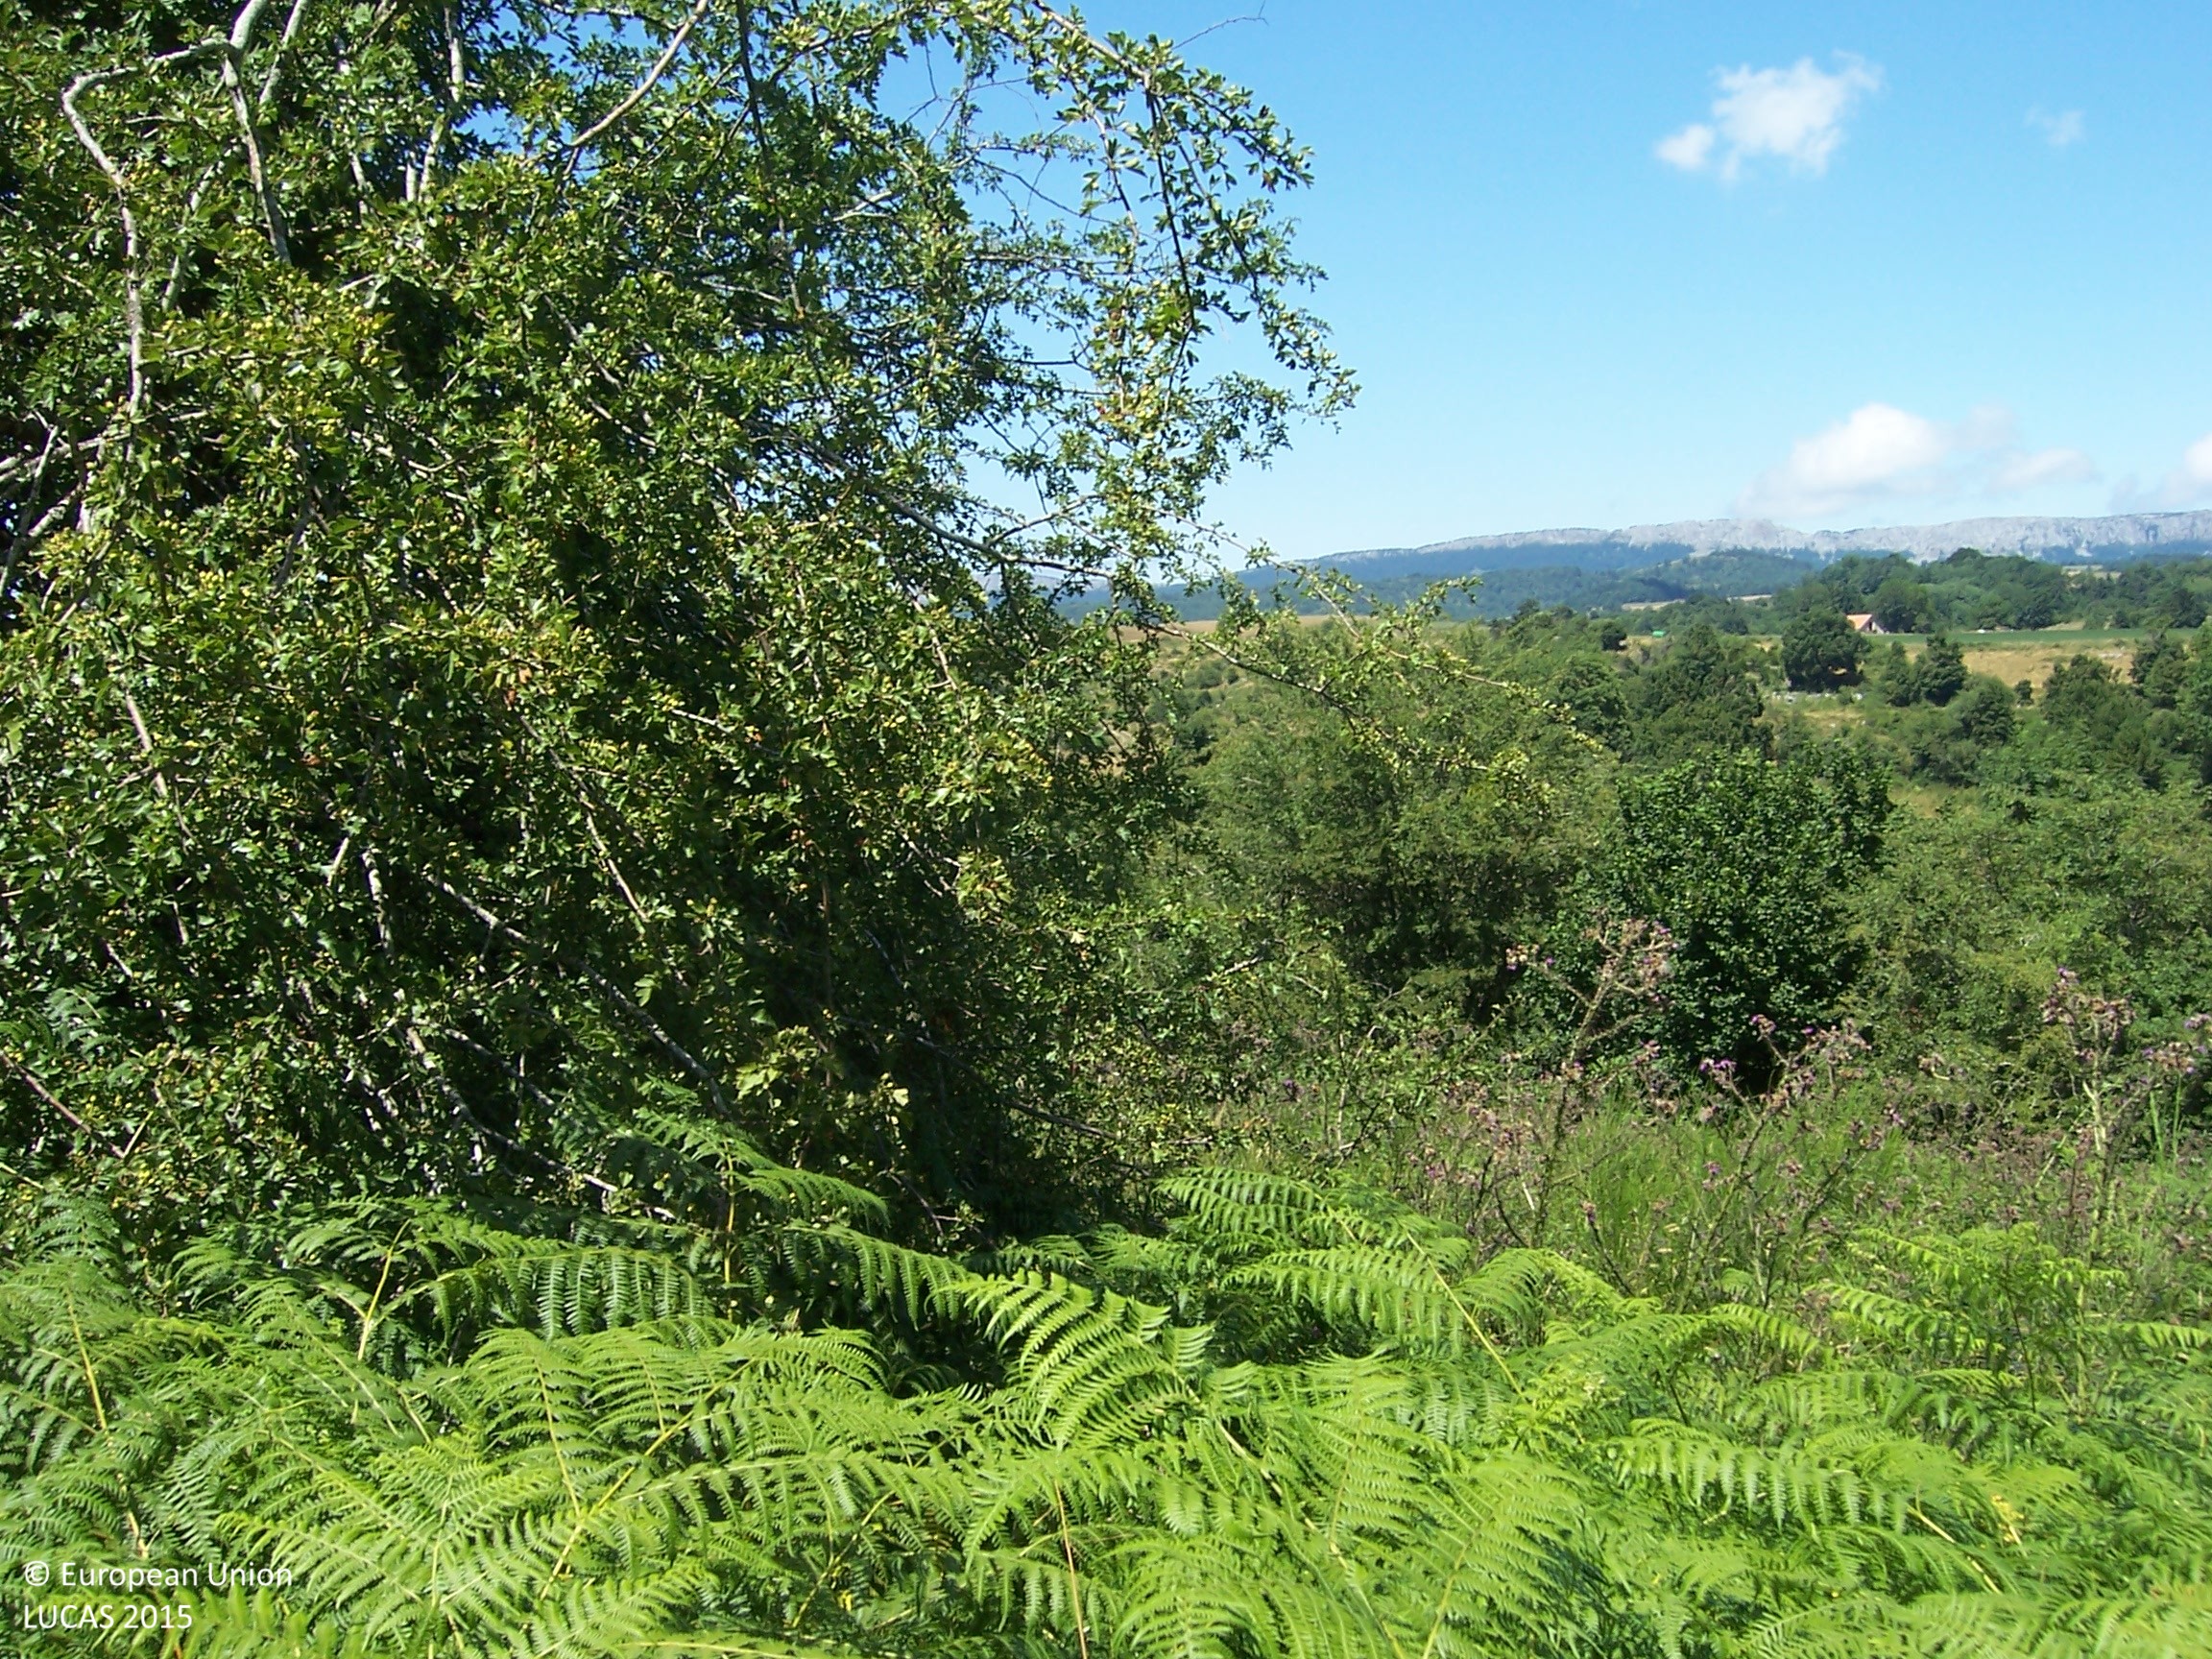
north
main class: Woodland
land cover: Broadleaved woodland
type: mountainous beech forest
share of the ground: > 75 %
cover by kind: broadleaved forest trees 100 %
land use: Forestry
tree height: > 5 m
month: July
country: ES
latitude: 42.8879
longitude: -1.1900
